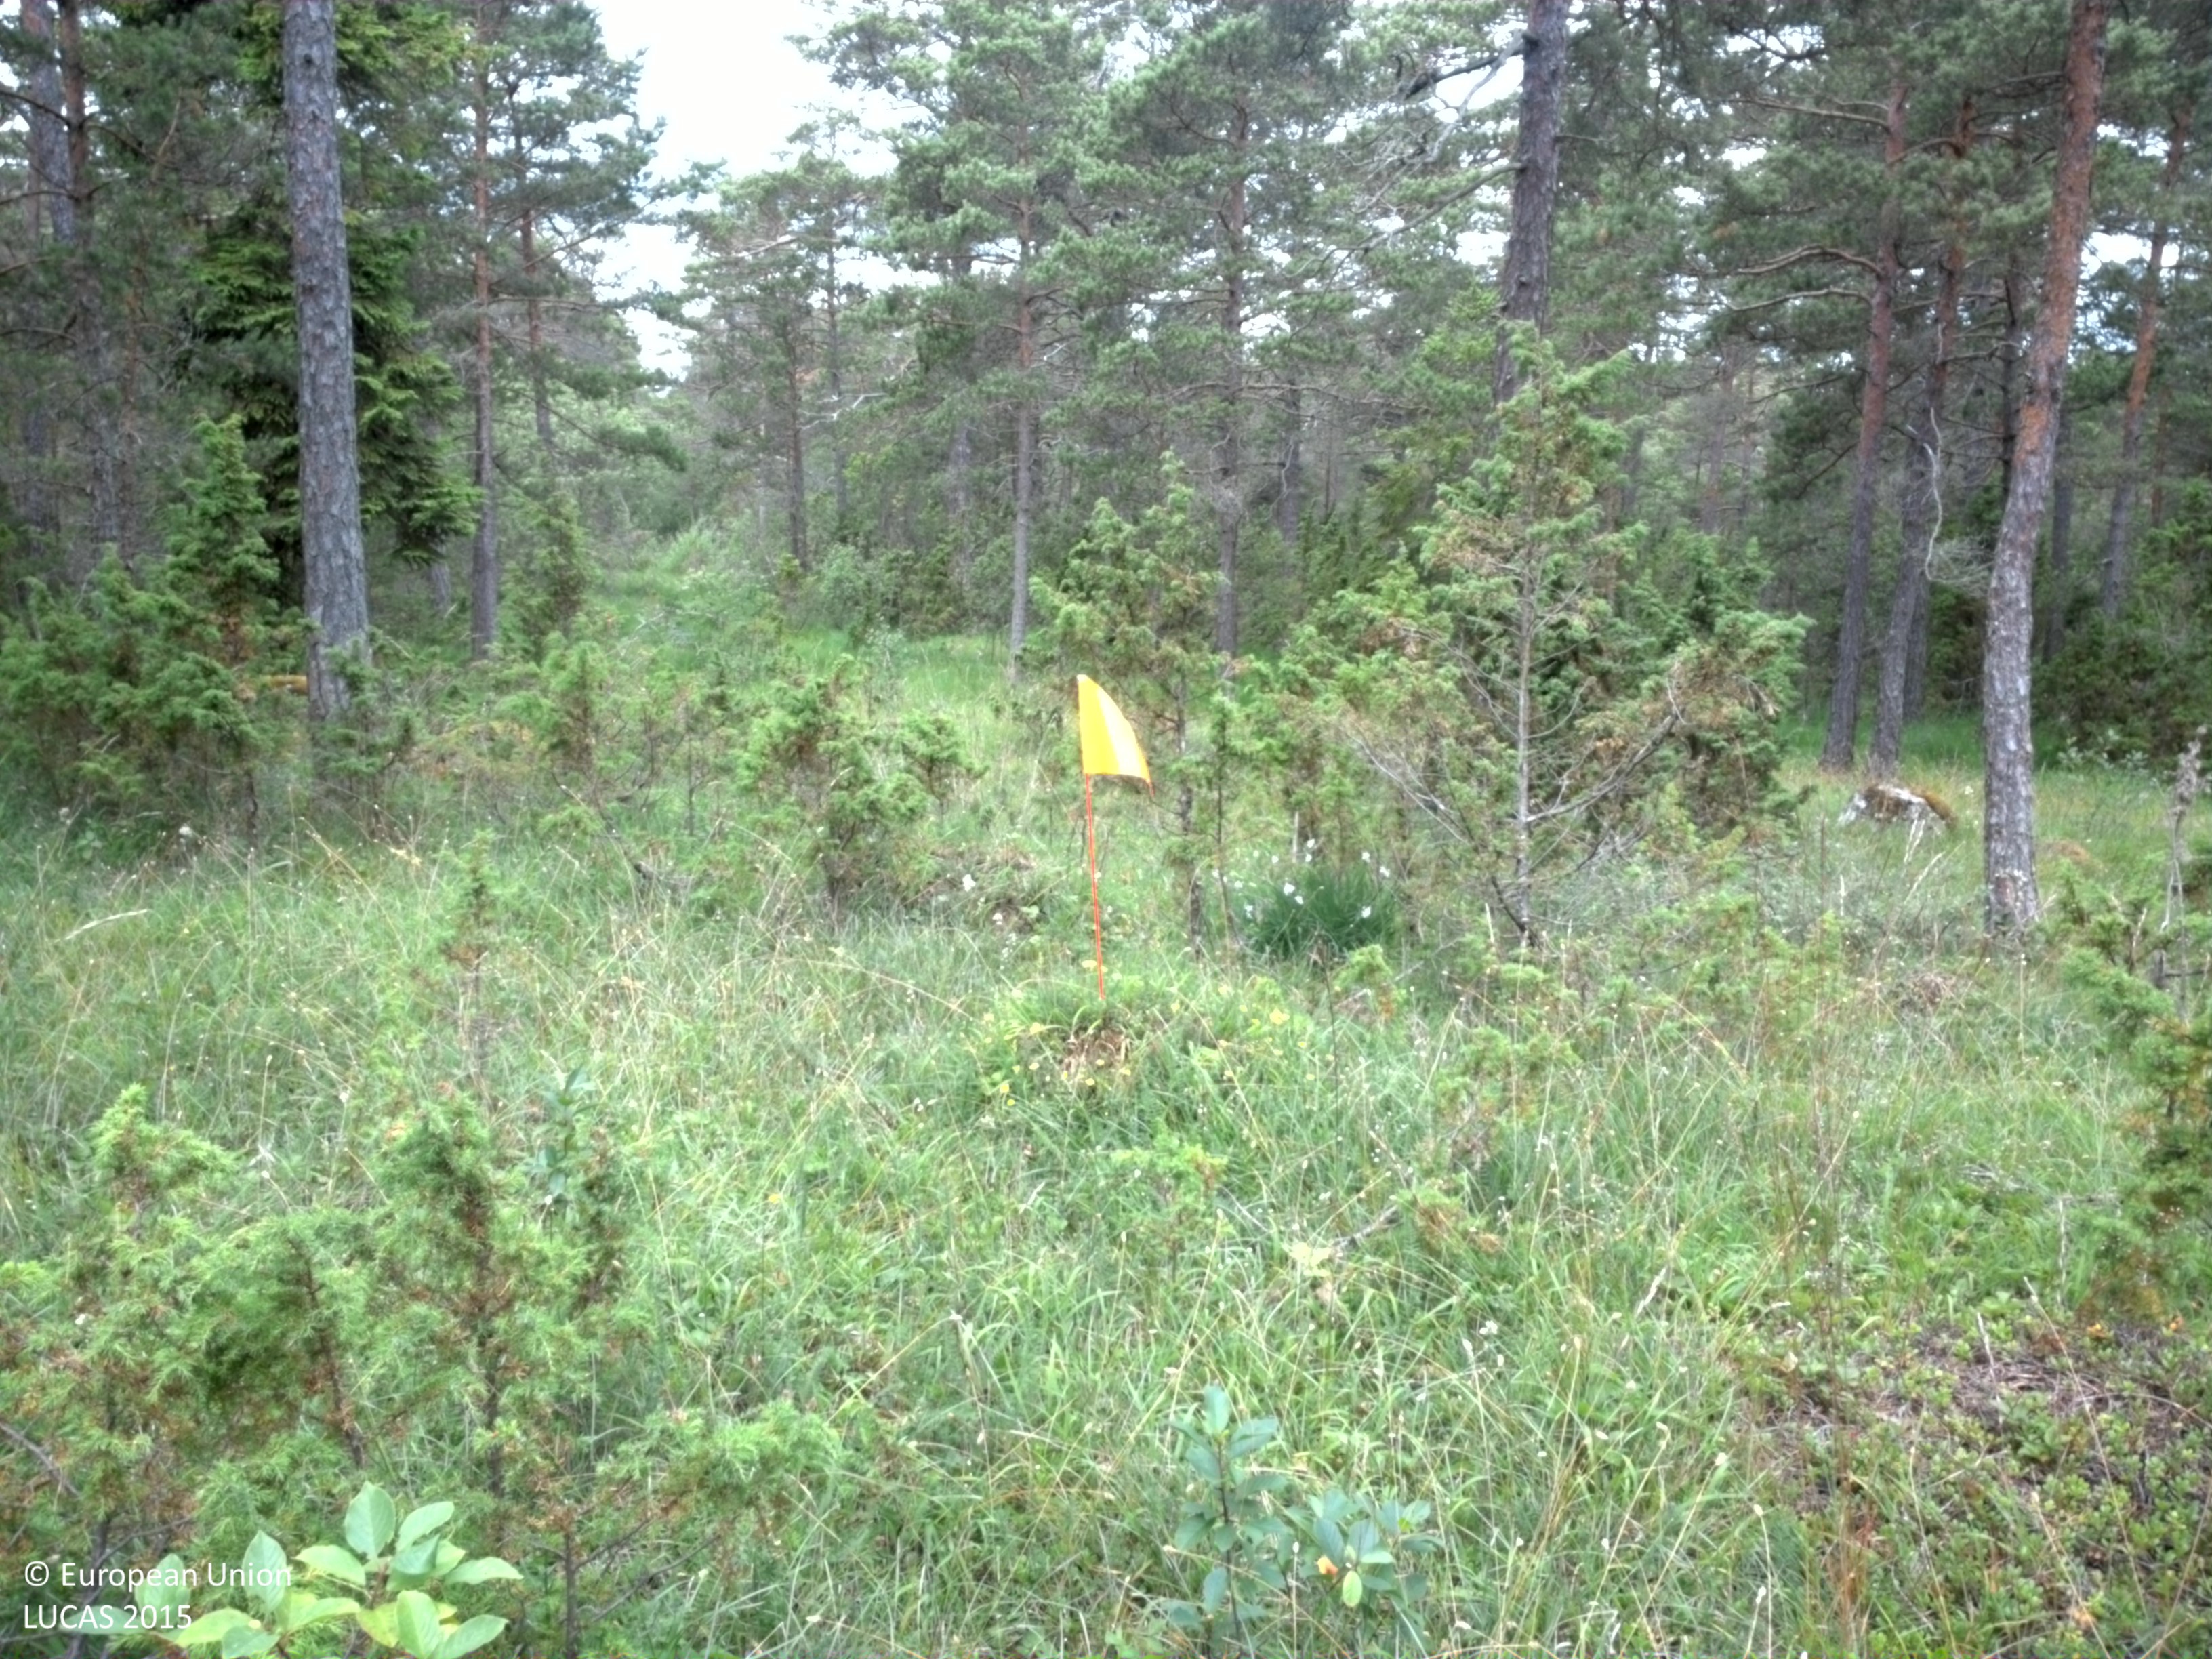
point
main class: Shrubland
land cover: Shrubland with sparse tree cover
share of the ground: 50 - 75 %
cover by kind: shrubs 55 %, herbaceous plants 40 %, coniferous forest trees 5 %
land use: Forestry
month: July
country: SE
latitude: 57.5423
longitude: 18.6468
